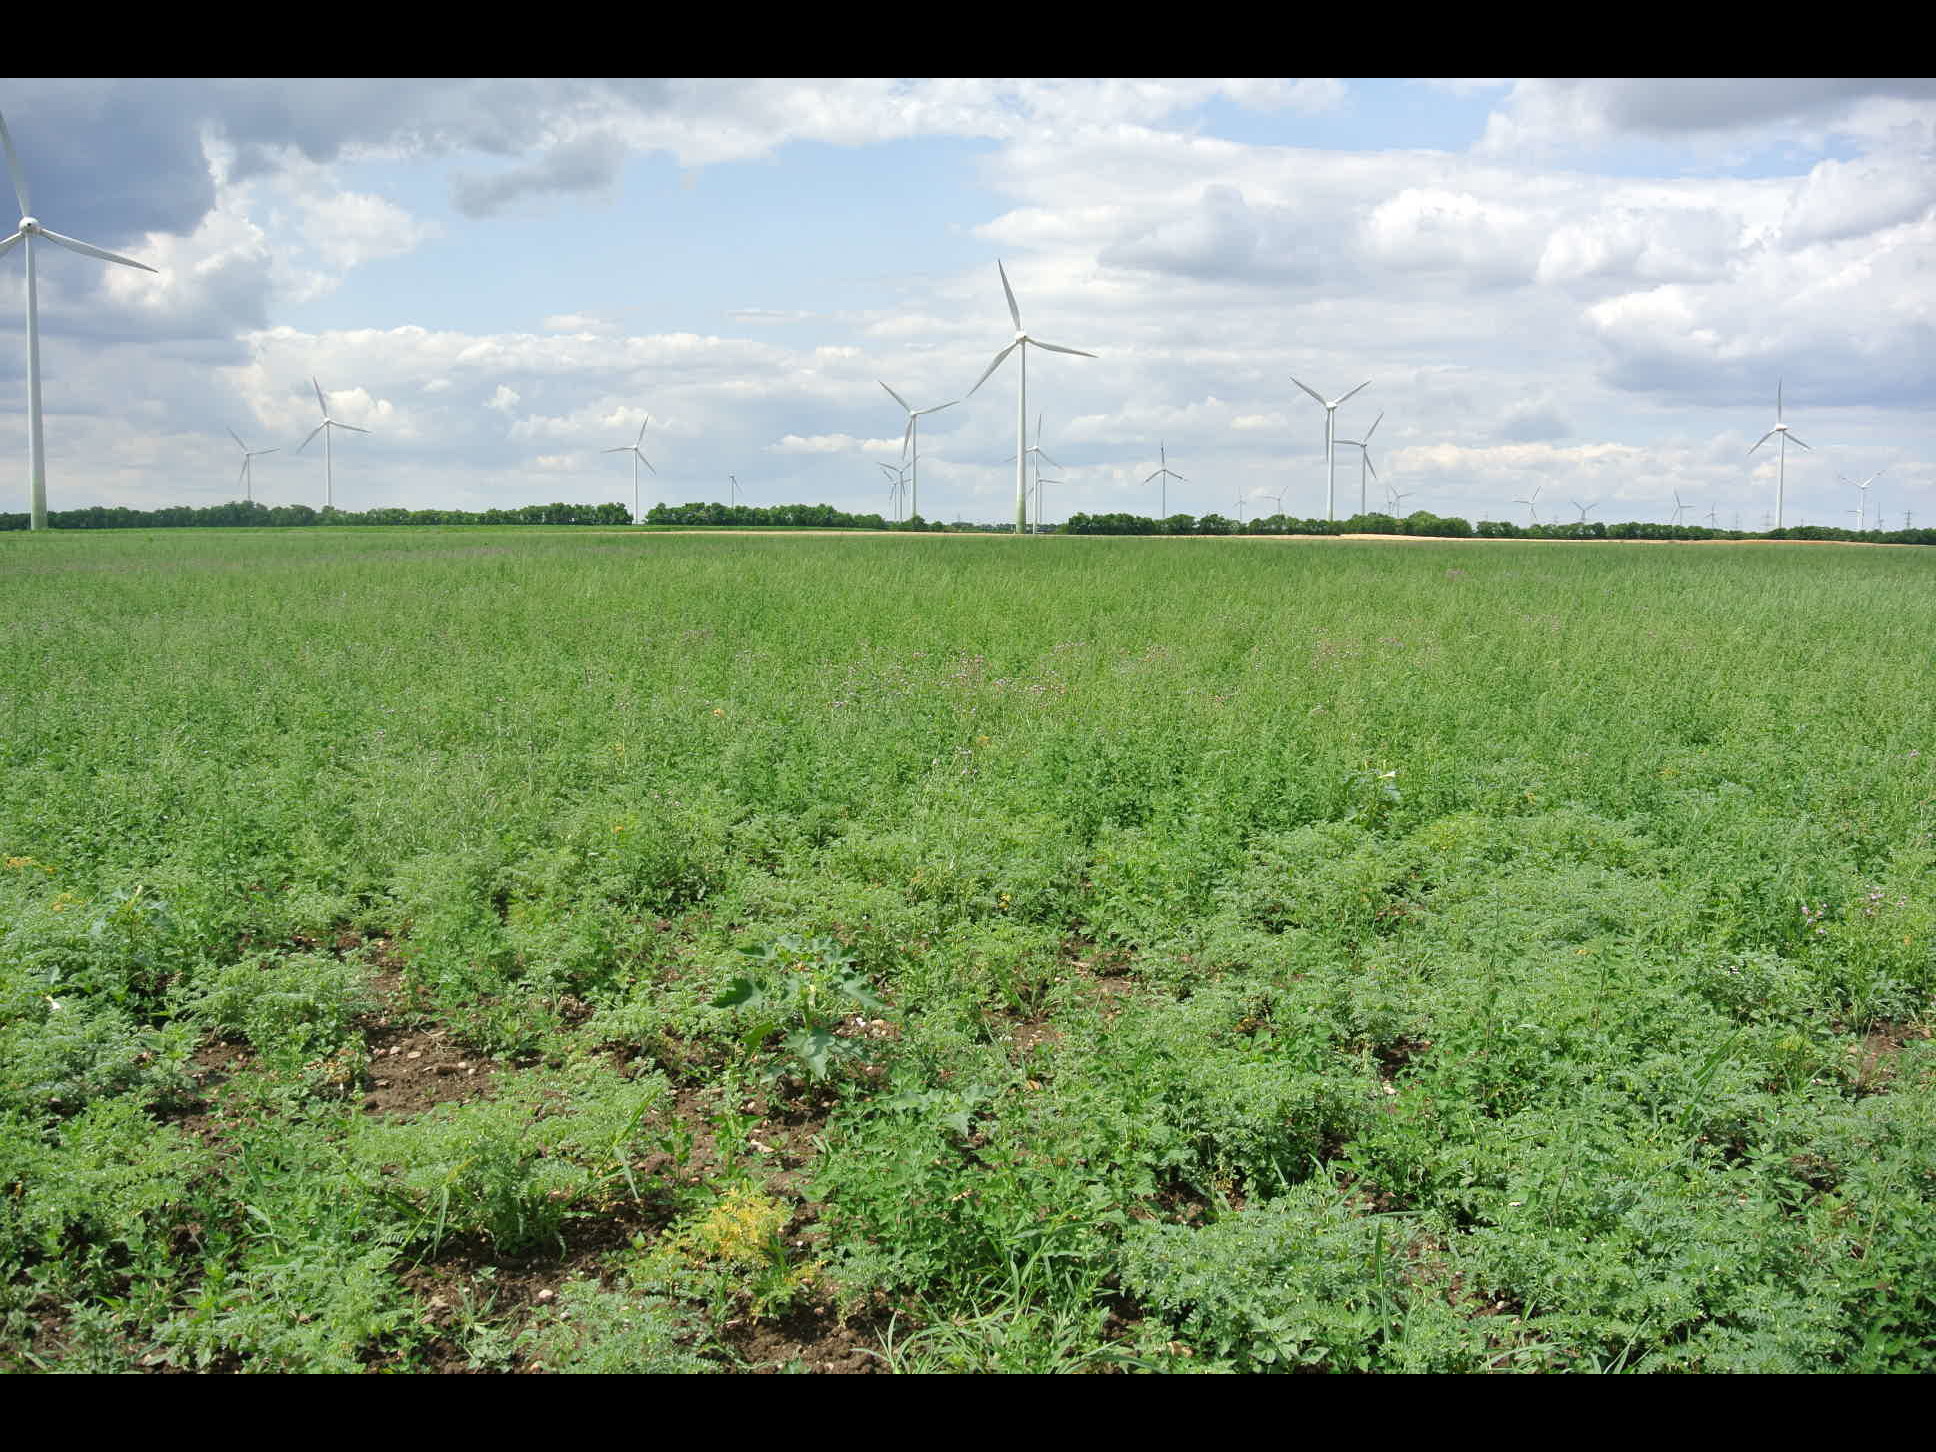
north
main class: Cropland
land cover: Dry pulses
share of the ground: > 75 %
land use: Agriculture (excluding fallow land and kitchen gardens)
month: July
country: AT
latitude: 47.9529
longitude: 16.9026
